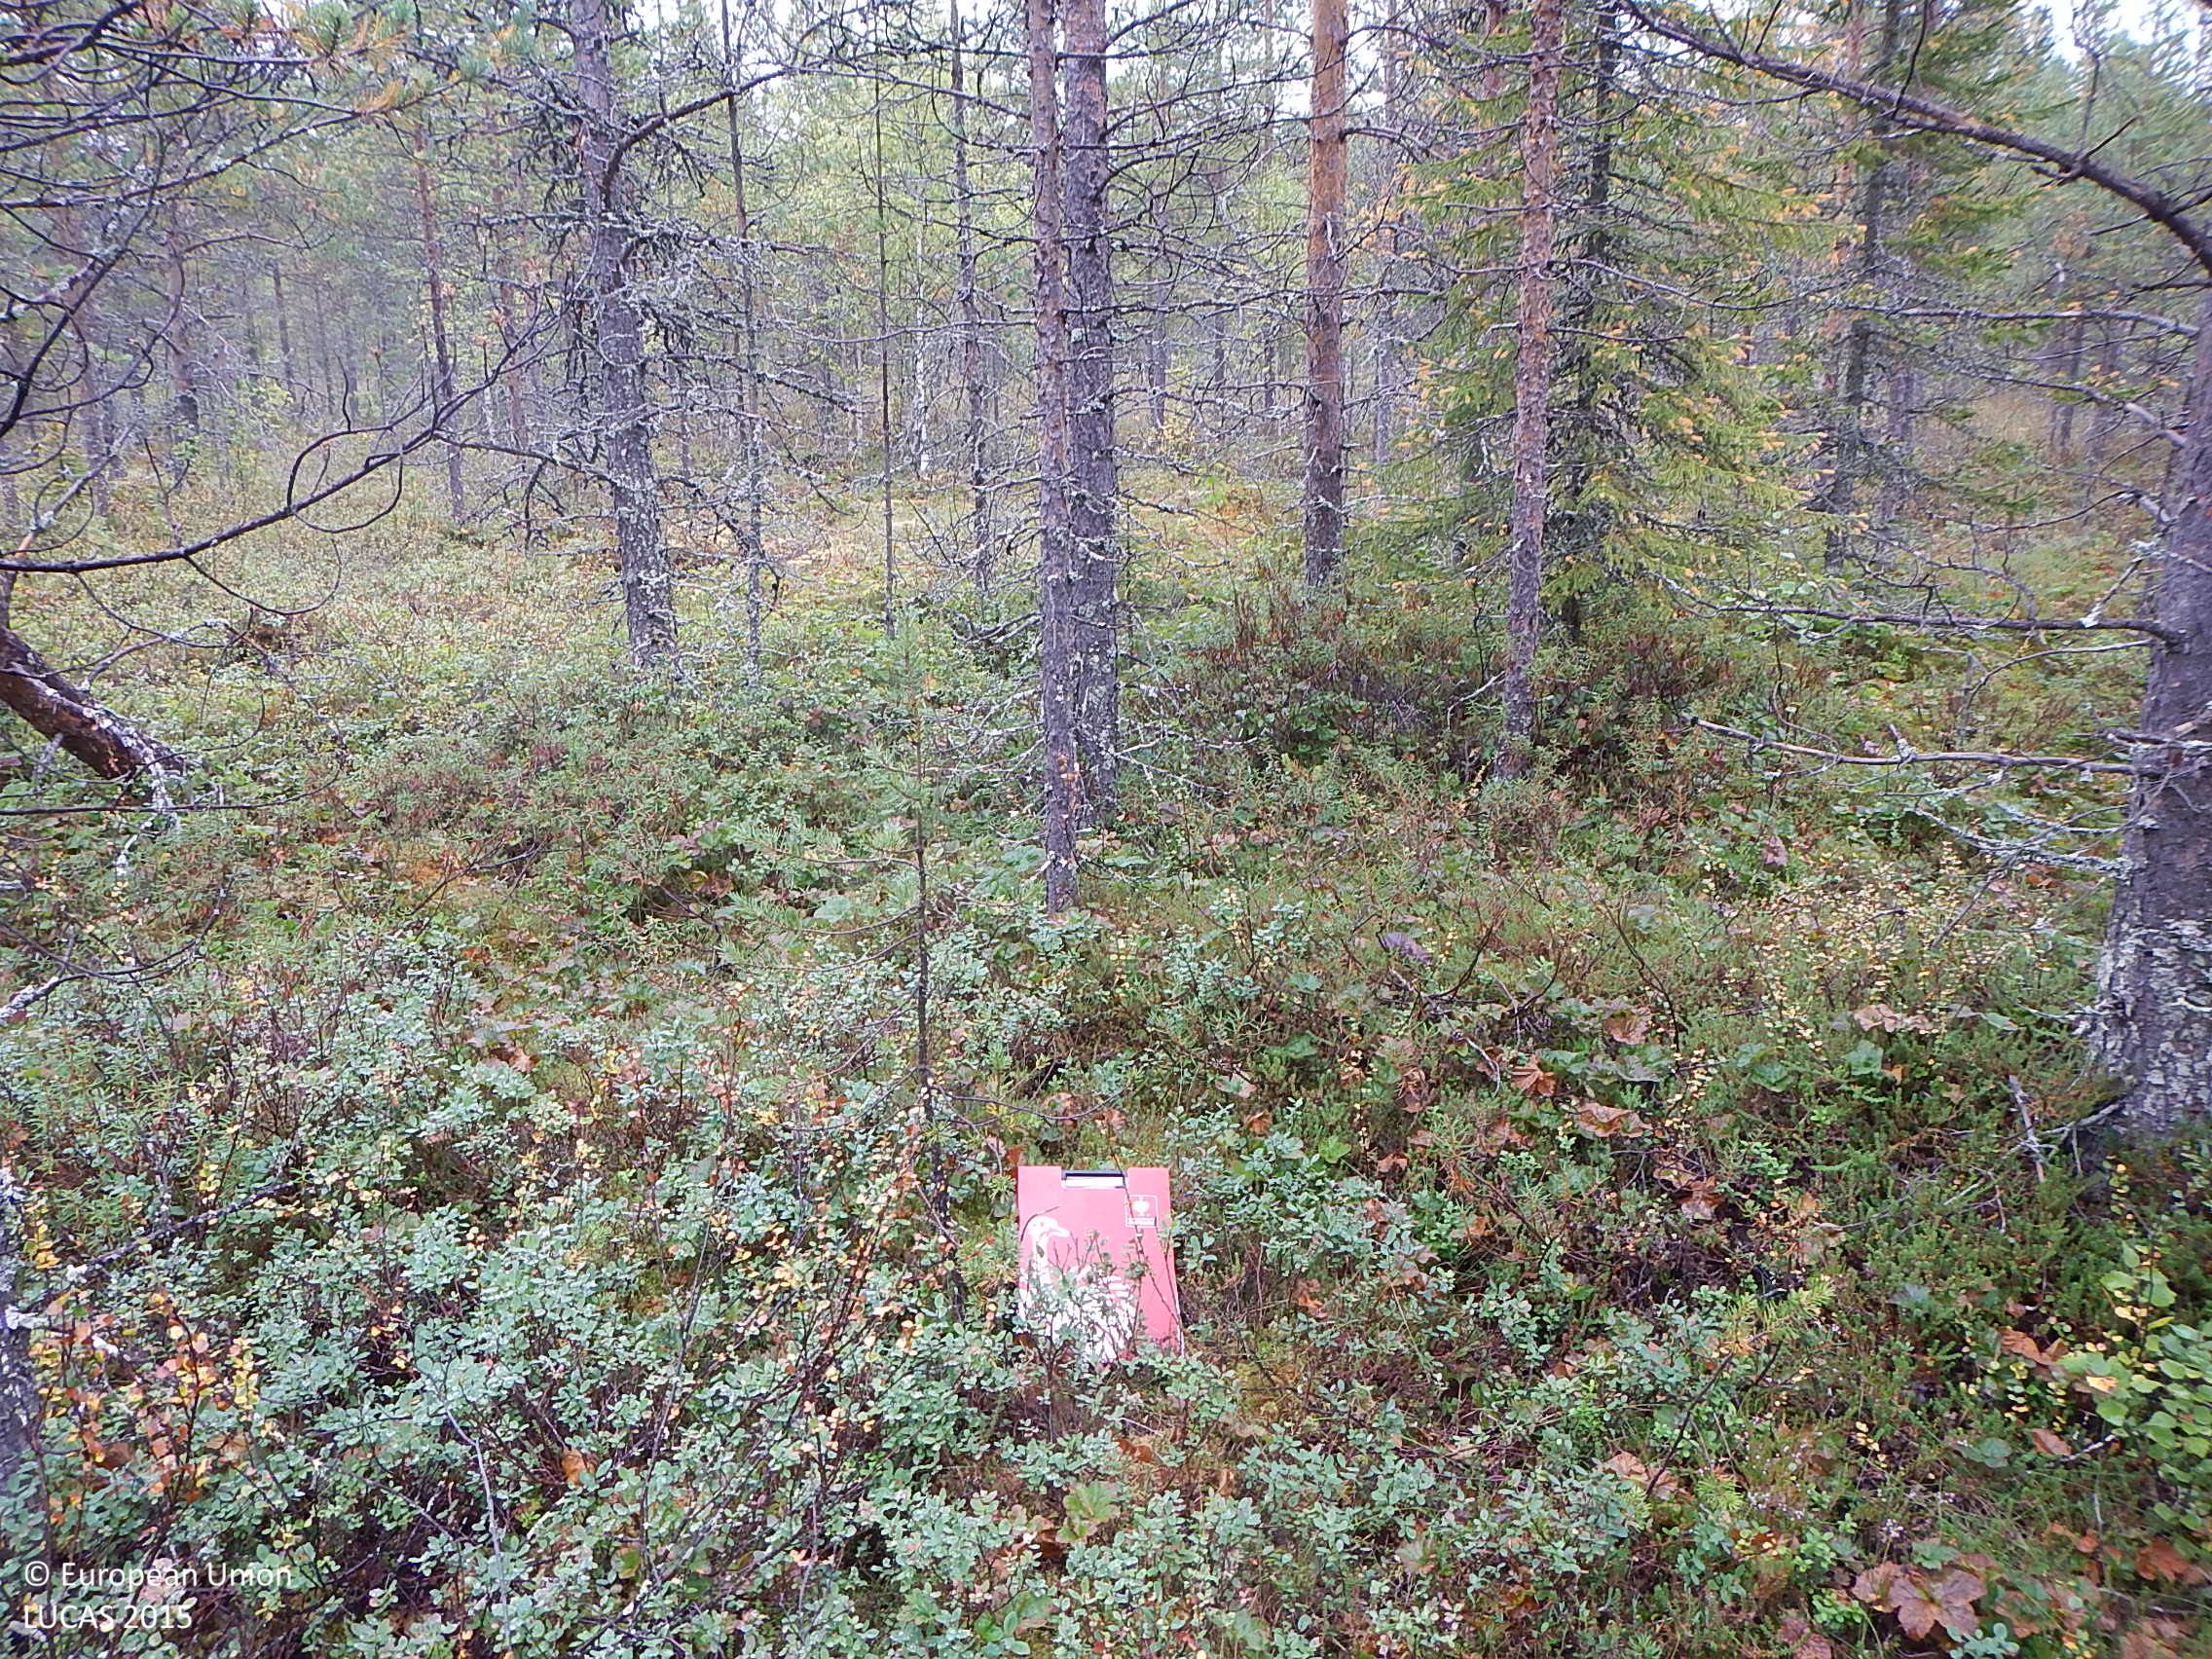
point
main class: Woodland
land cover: Pine dominated coniferous woodland
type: boreal forest
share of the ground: 50 - 75 %
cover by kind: coniferous forest trees 60 %, shrubs 30 %, broadleaved forest trees 5 %, herbaceous plants 5 %
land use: Forestry
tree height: > 5 m
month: August
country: FI
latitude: 65.9633
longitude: 27.3453
